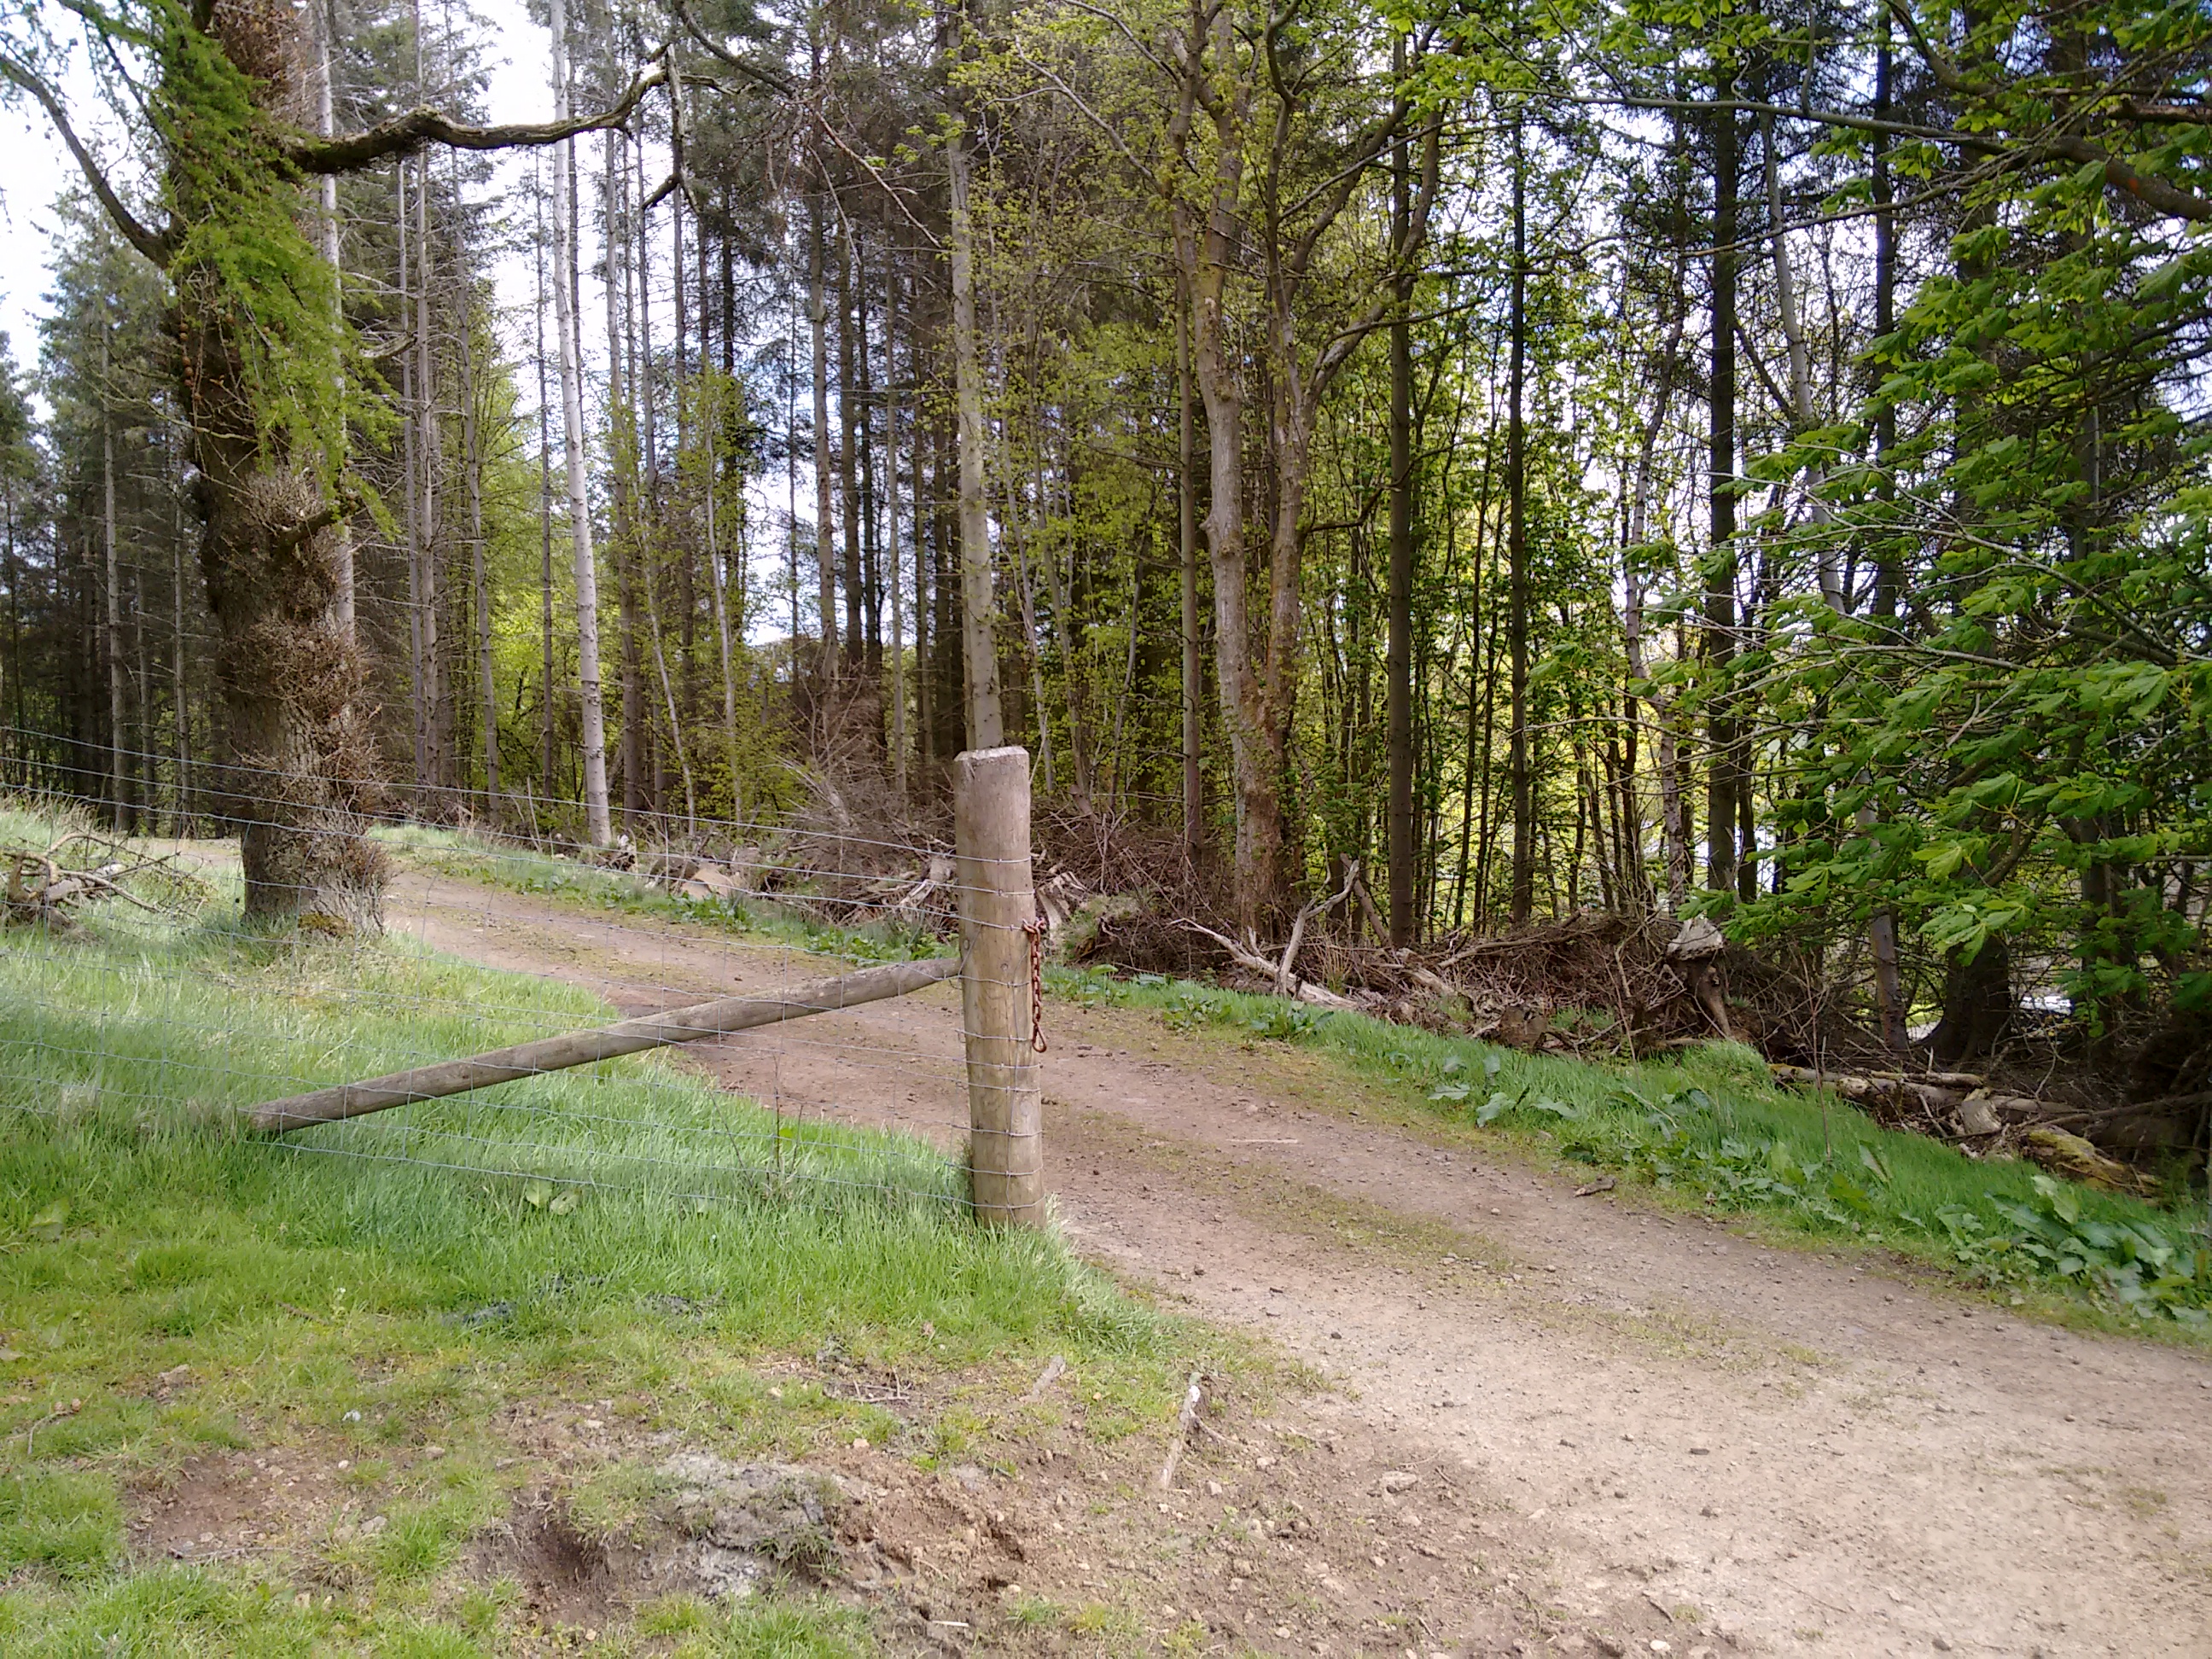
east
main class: Grassland
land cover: Grassland without tree/shrub cover
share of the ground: > 75 %
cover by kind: herbaceous plants 100 %
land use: Agriculture (excluding fallow land and kitchen gardens)
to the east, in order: Grassland without tree/shrub cover; Fences; Other mixed woodland; Tracks; Spruce dominated mixed woodland; Fences; Grassland with sparse tree/shrub cover; Fences; Broadleaved woodland; Fences; Grassland without tree/shrub cover
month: May
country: GB
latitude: 55.9476
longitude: -3.6432
